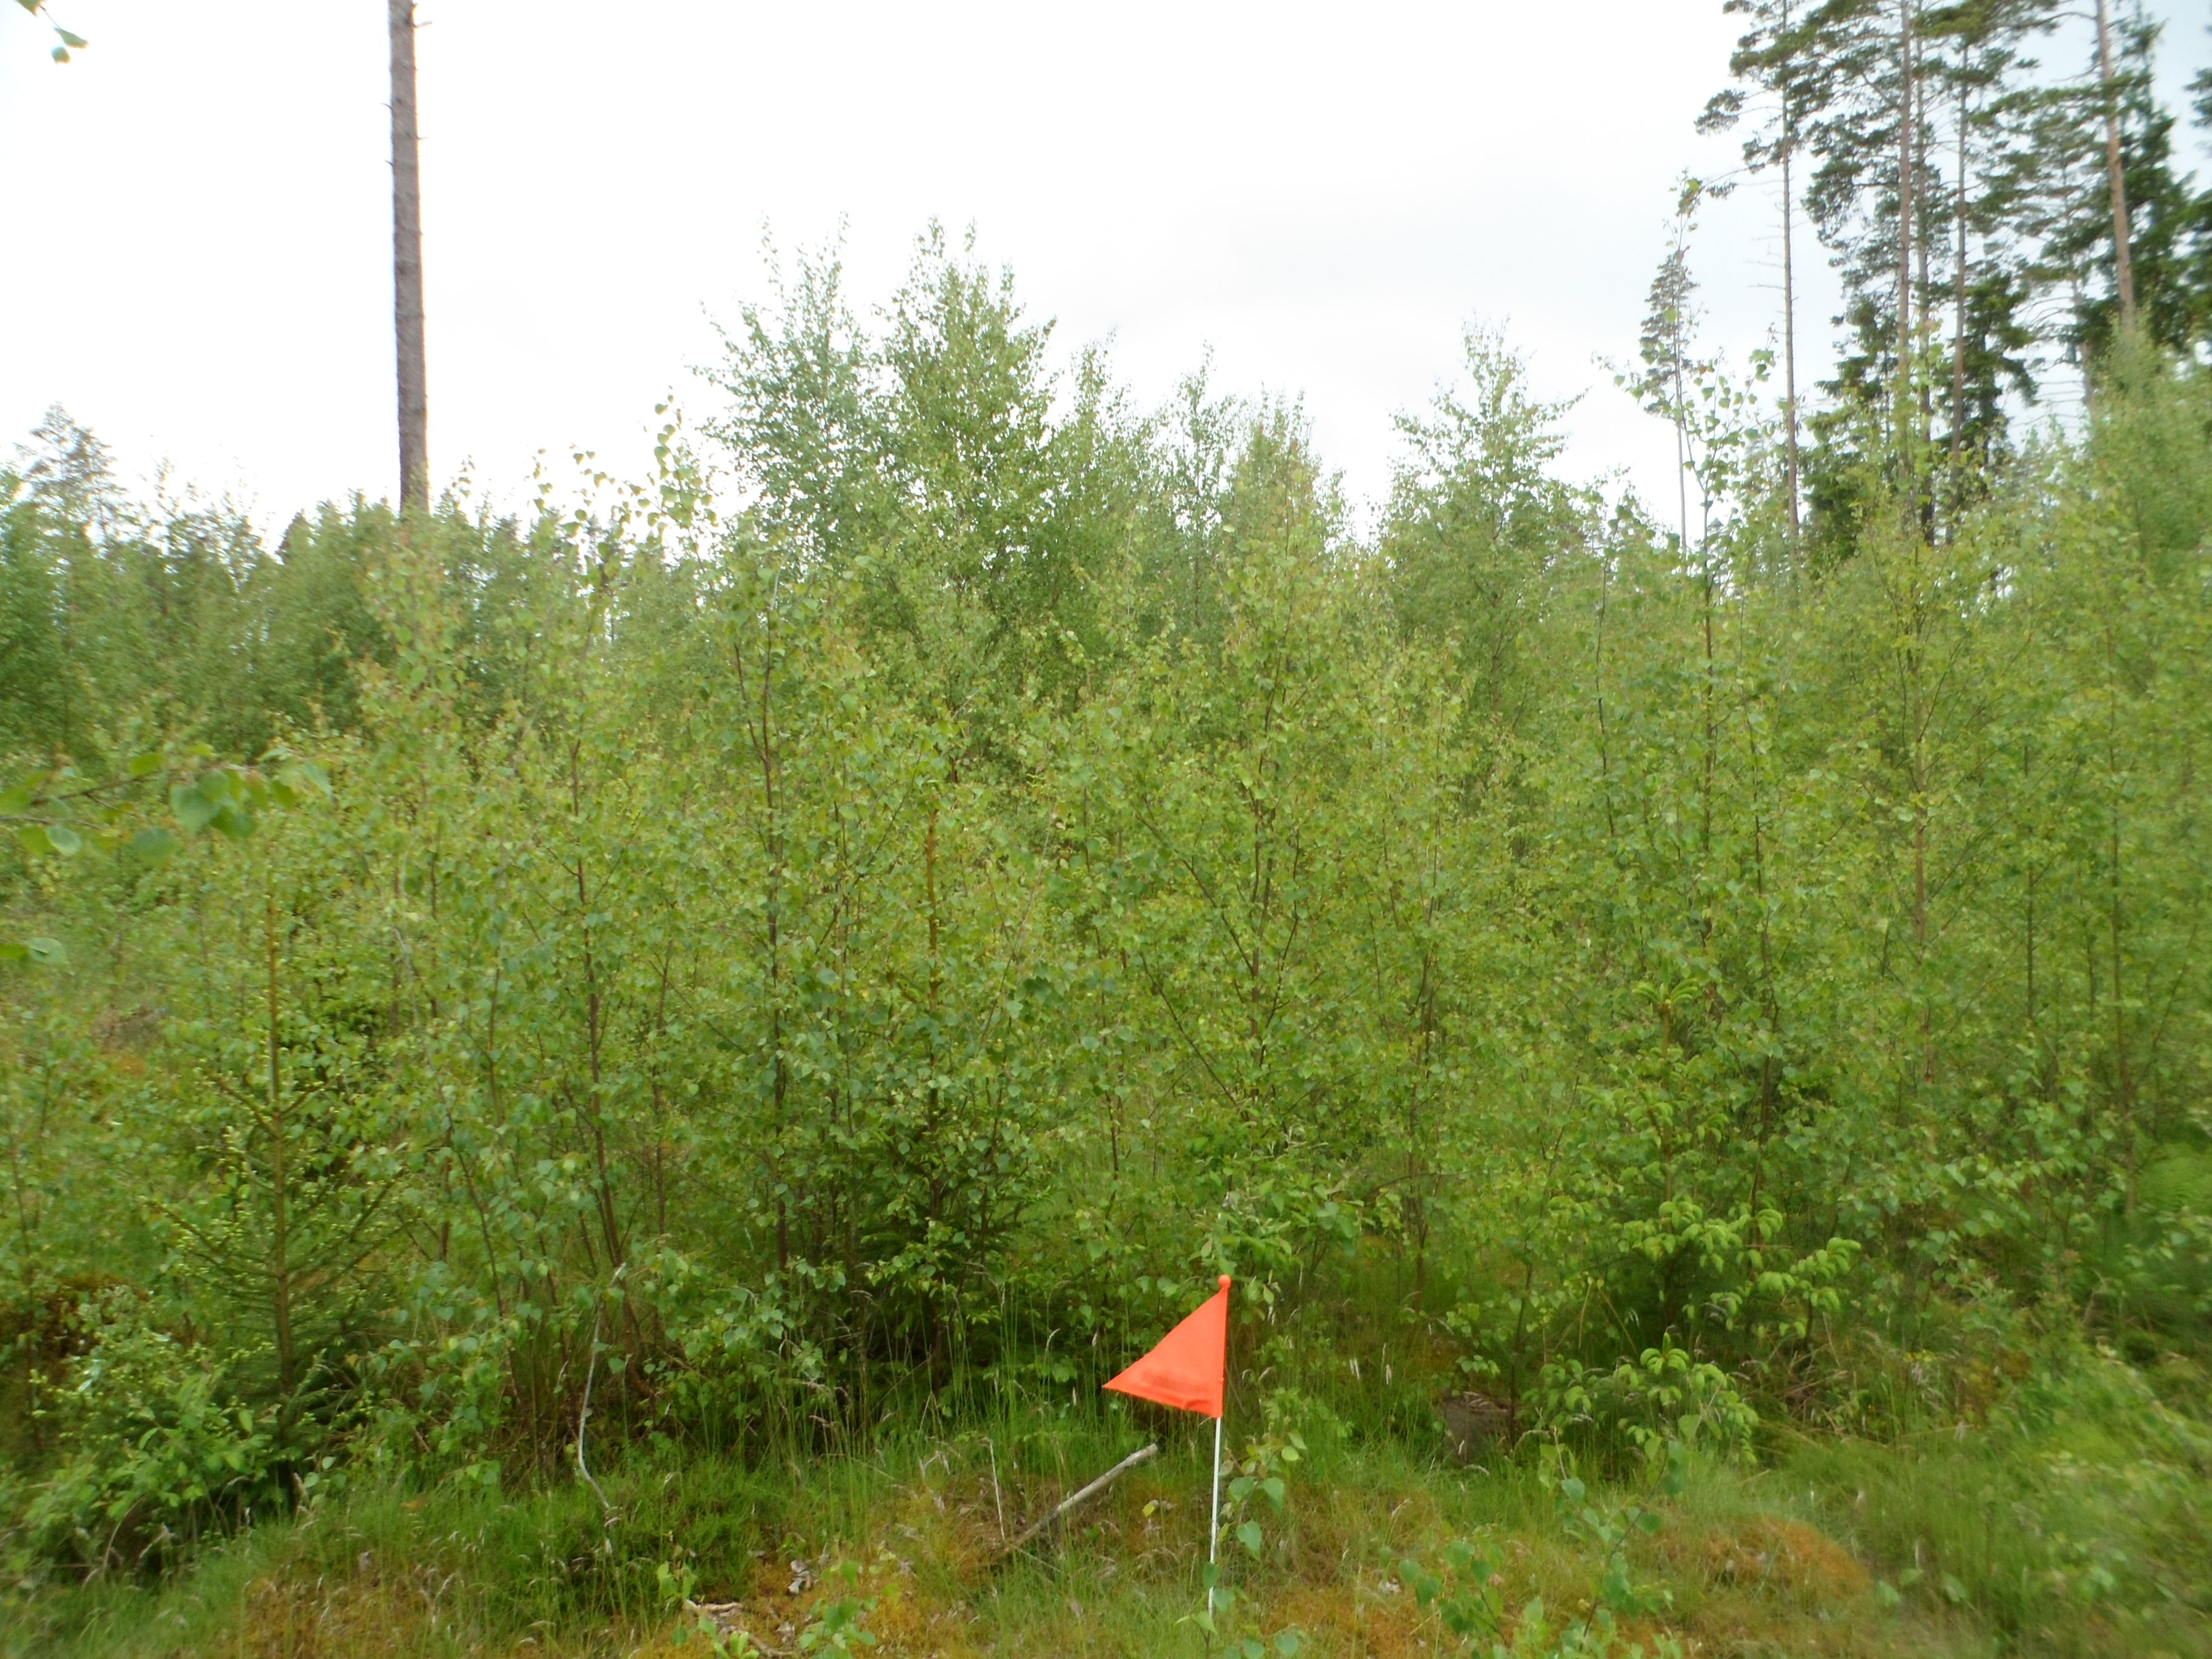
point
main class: Woodland
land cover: Broadleaved woodland
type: boreal forest
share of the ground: > 75 %
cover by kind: broadleaved forest trees 75 %, herbaceous plants 10 %, coniferous forest trees 5 %, shrubs 5 %, lichens and mosses 5 %
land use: Forestry
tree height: < 5 m
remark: Clear cut
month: June
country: SE
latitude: 56.9154
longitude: 14.6124
